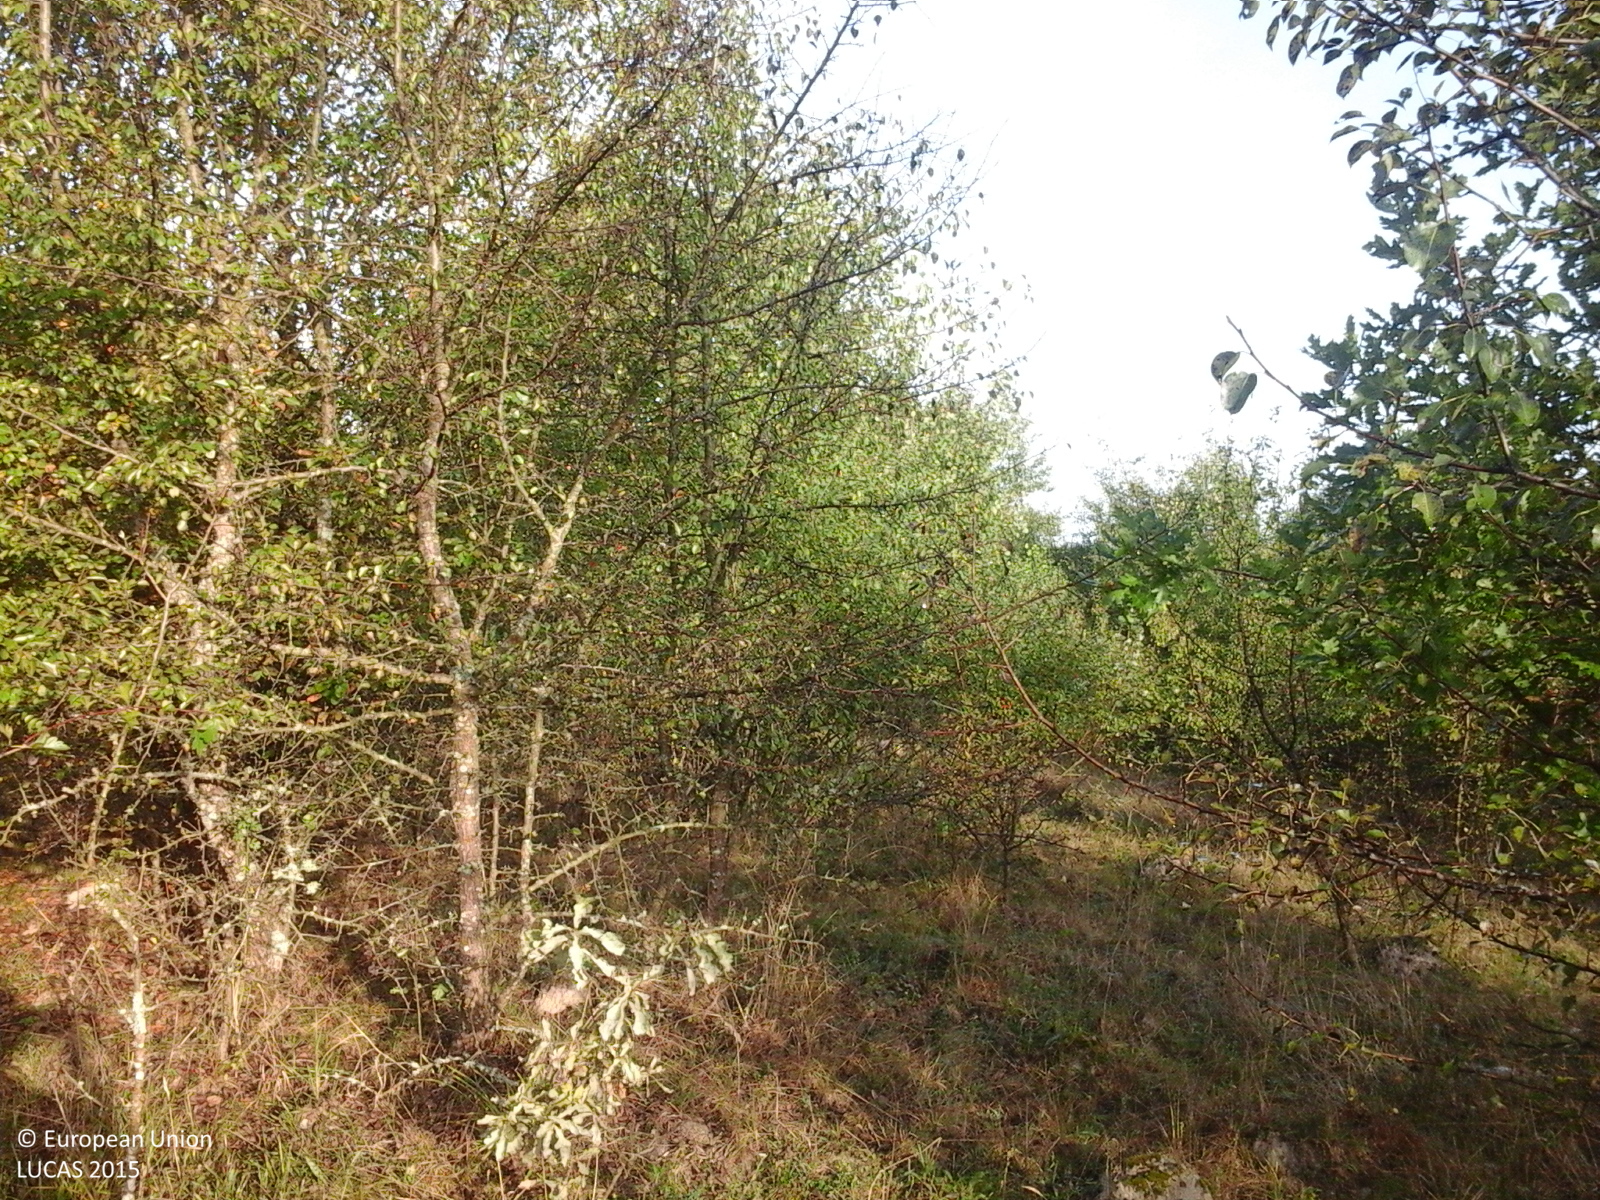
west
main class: Grassland
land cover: Grassland with sparse tree/shrub cover
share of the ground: > 75 %
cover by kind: herbaceous plants 85 %, shrubs 10 %, broadleaved forest trees 5 %
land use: Agriculture (excluding fallow land and kitchen gardens)
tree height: > 5 m
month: September
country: RO
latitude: 46.8947
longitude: 23.3638
